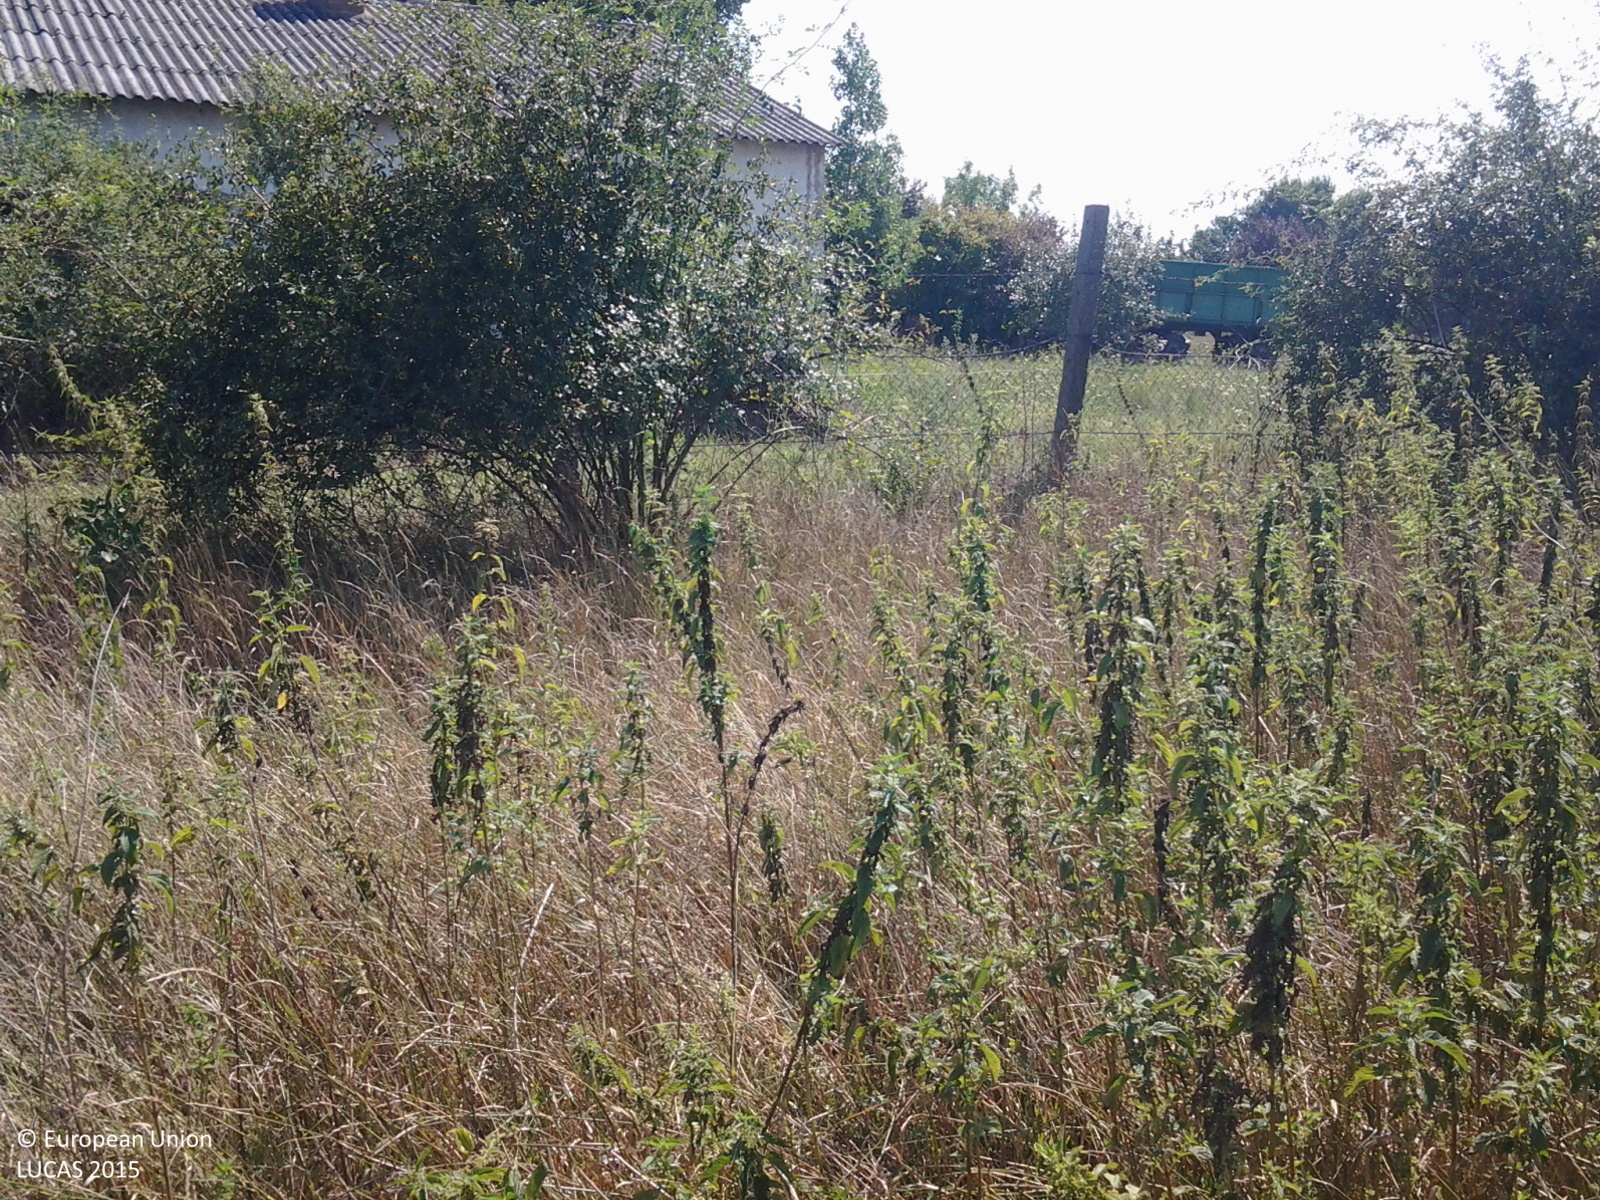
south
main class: Grassland
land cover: Grassland without tree/shrub cover
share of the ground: > 75 %
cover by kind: herbaceous plants 100 %
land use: Agriculture (excluding fallow land and kitchen gardens)
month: August
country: HU
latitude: 47.2077
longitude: 19.7792
